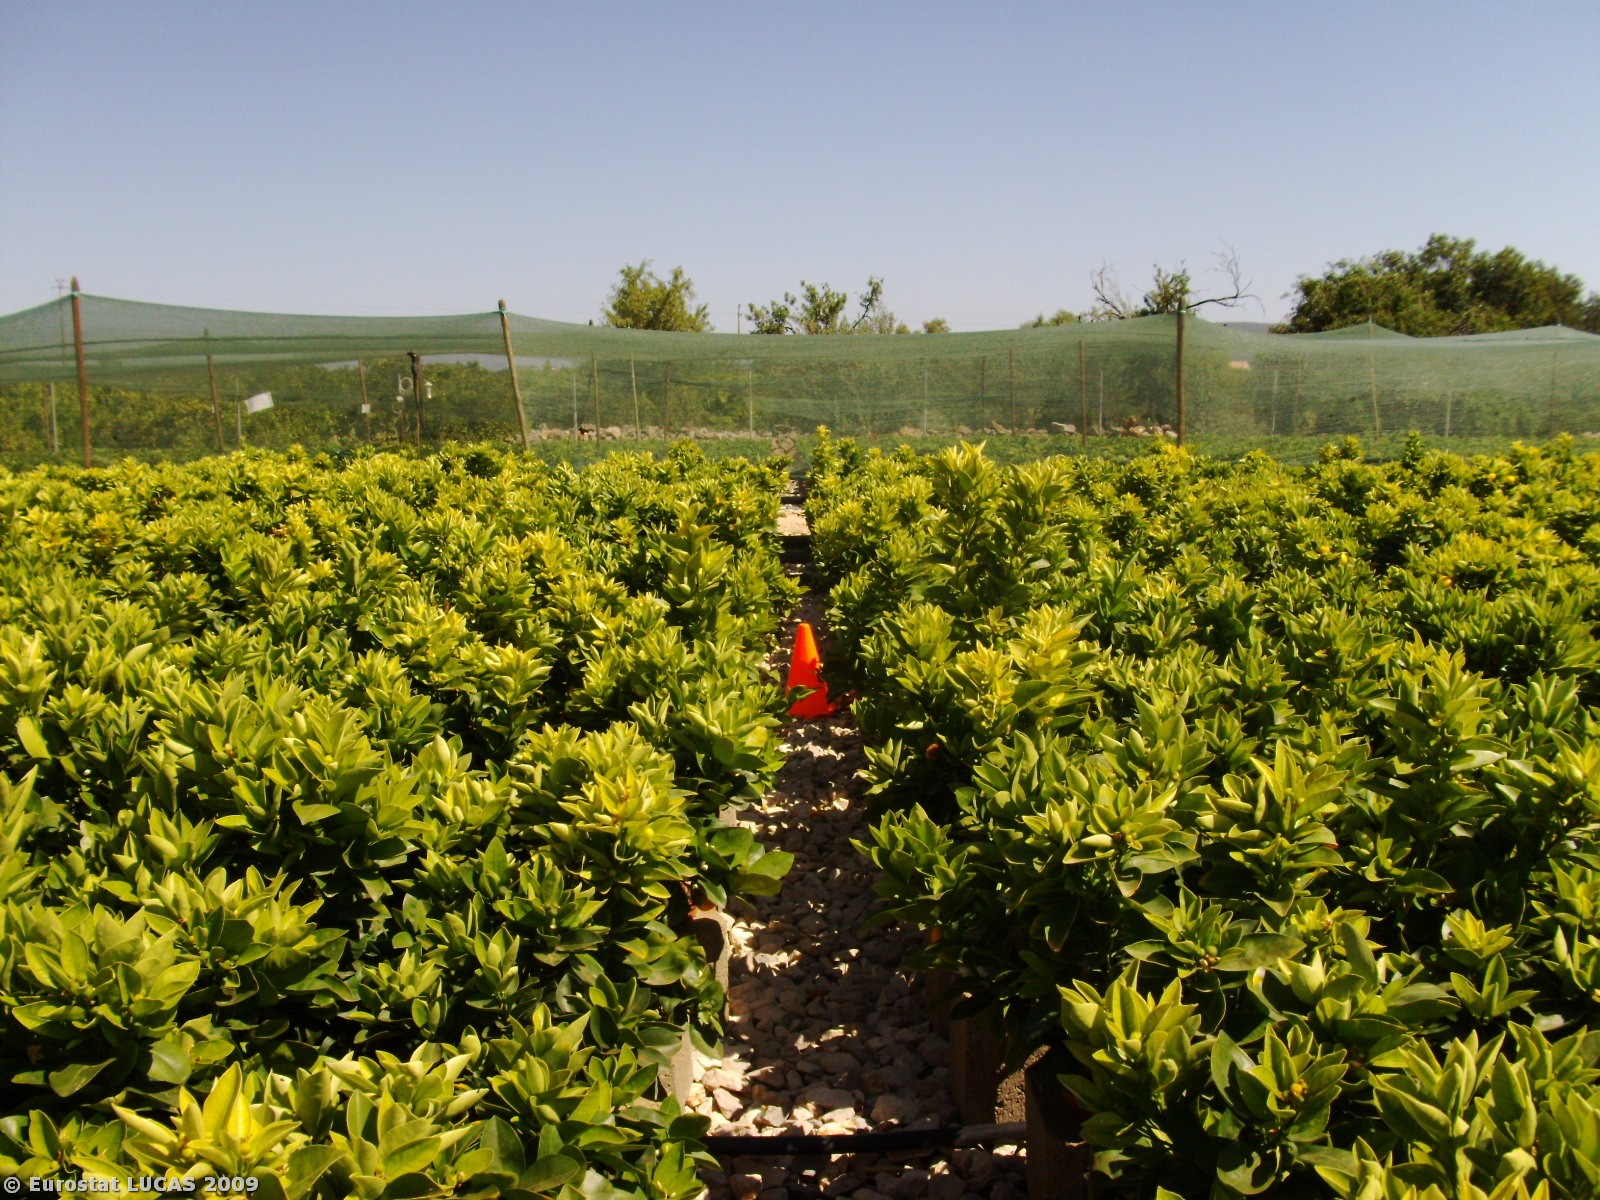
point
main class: Cropland
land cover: Nurseries
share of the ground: > 75 %
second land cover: Bare land
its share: < 10 %
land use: Agriculture (excluding fallow land and kitchen gardens)
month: May
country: PT
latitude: 37.1909
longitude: -8.2352
